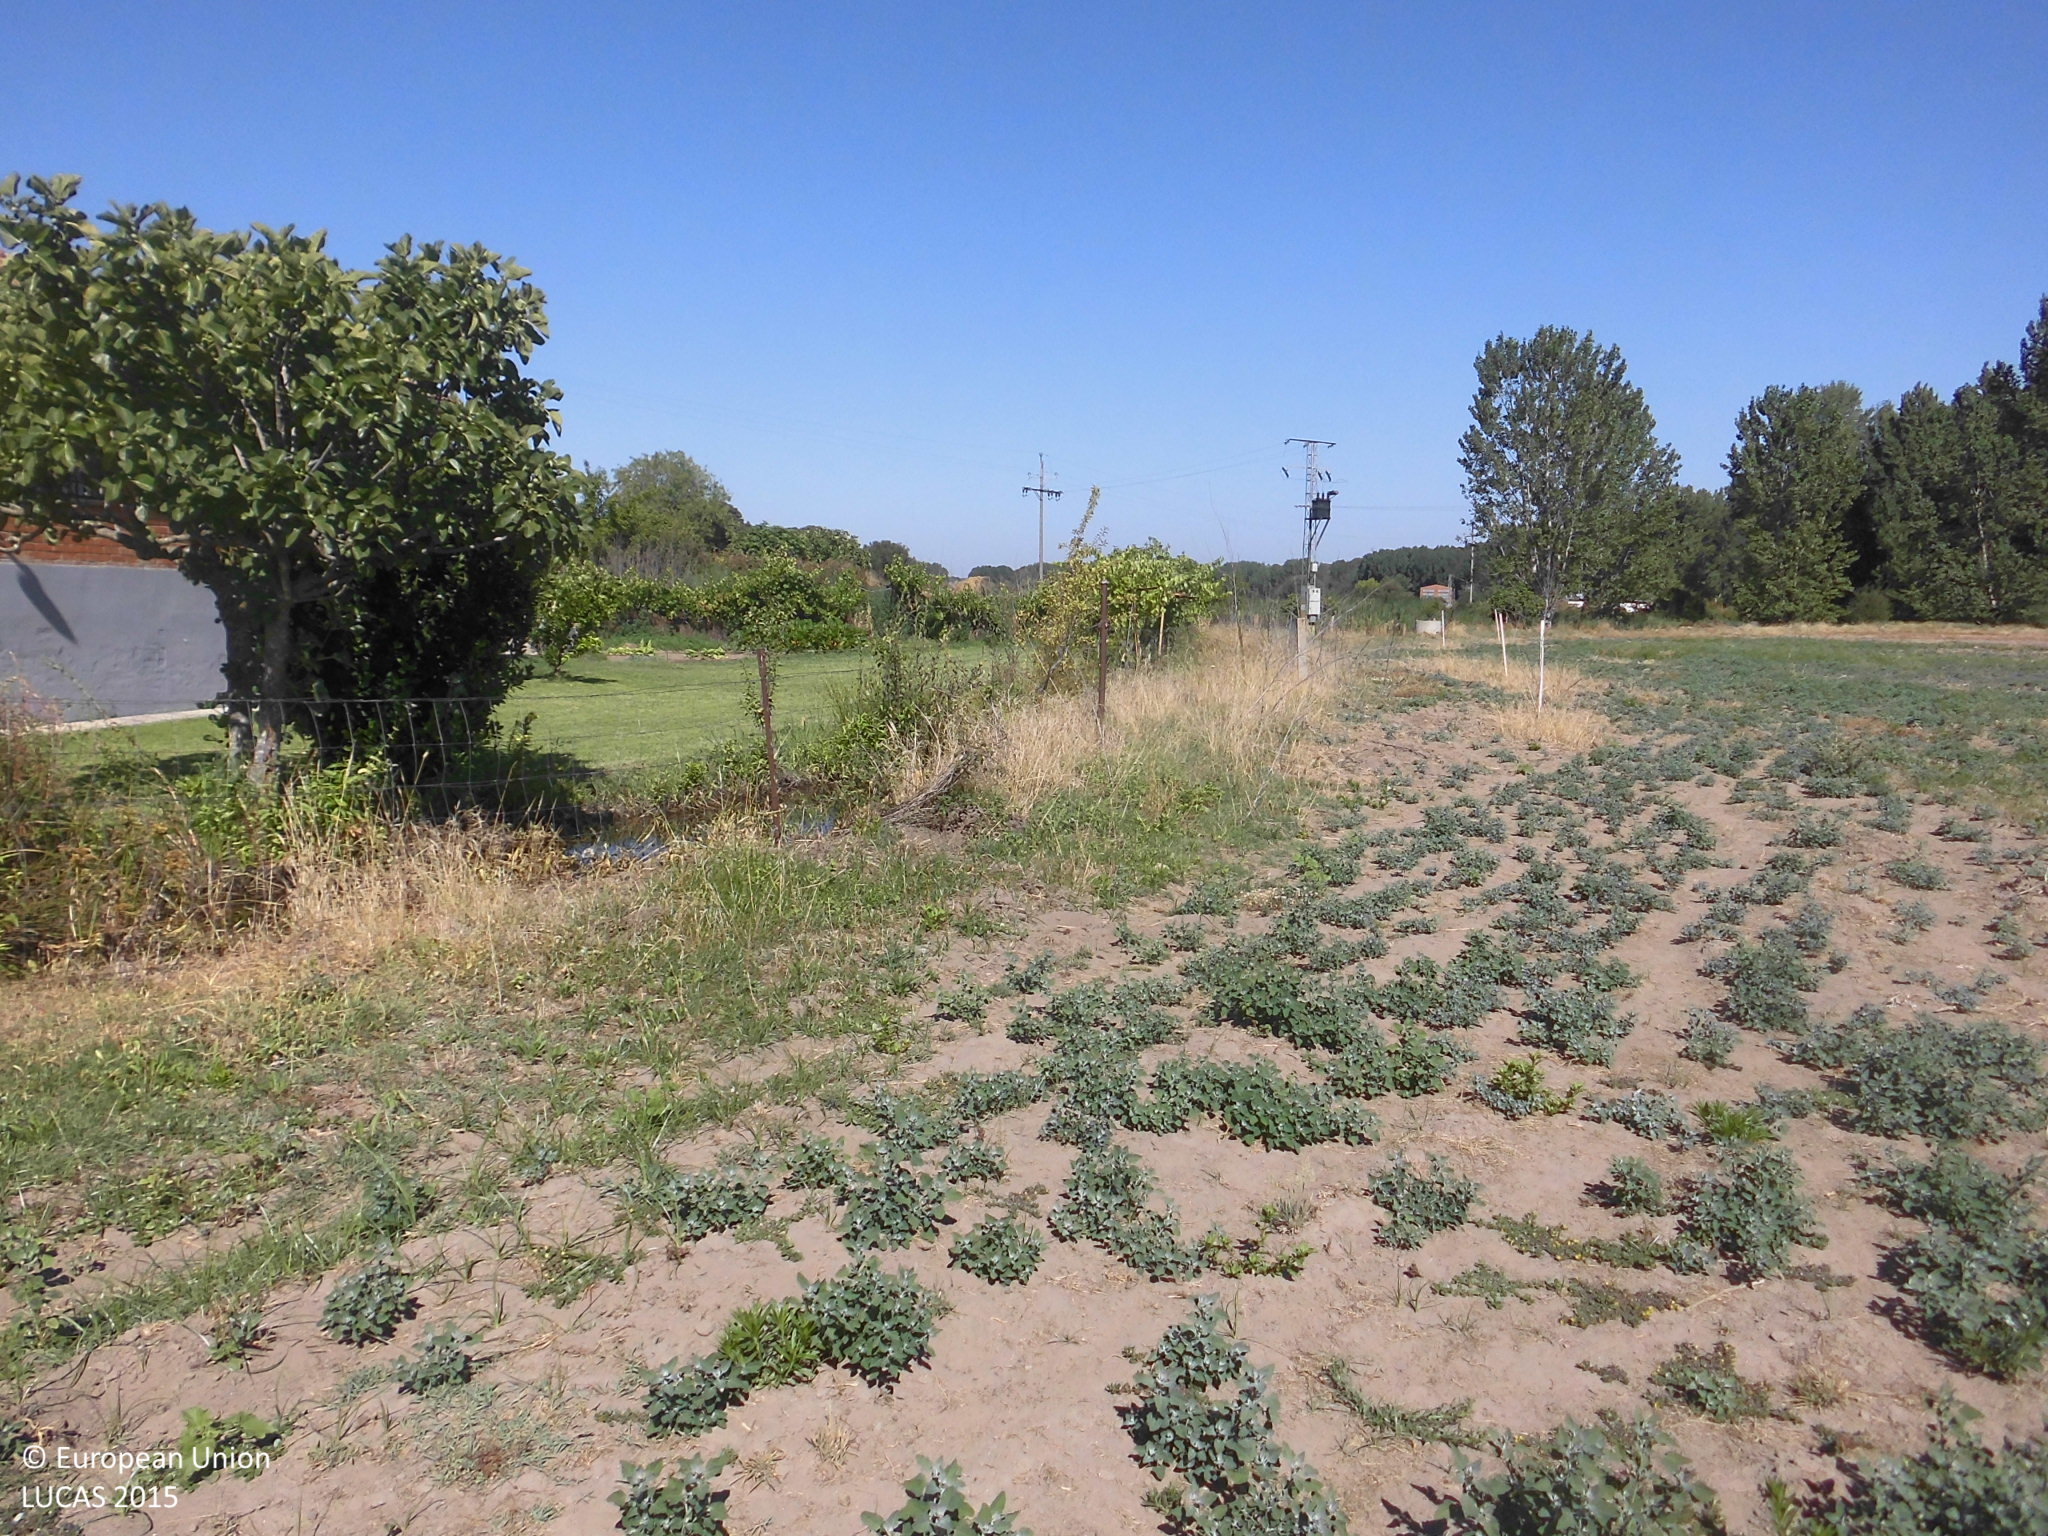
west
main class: Grassland
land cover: Spontaneously vegetated surfaces
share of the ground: > 75 %
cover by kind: herbaceous plants 90 %, unconsolidated bare surface 10 %
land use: Fallow land
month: July
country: ES
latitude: 40.0611
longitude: -6.1463
